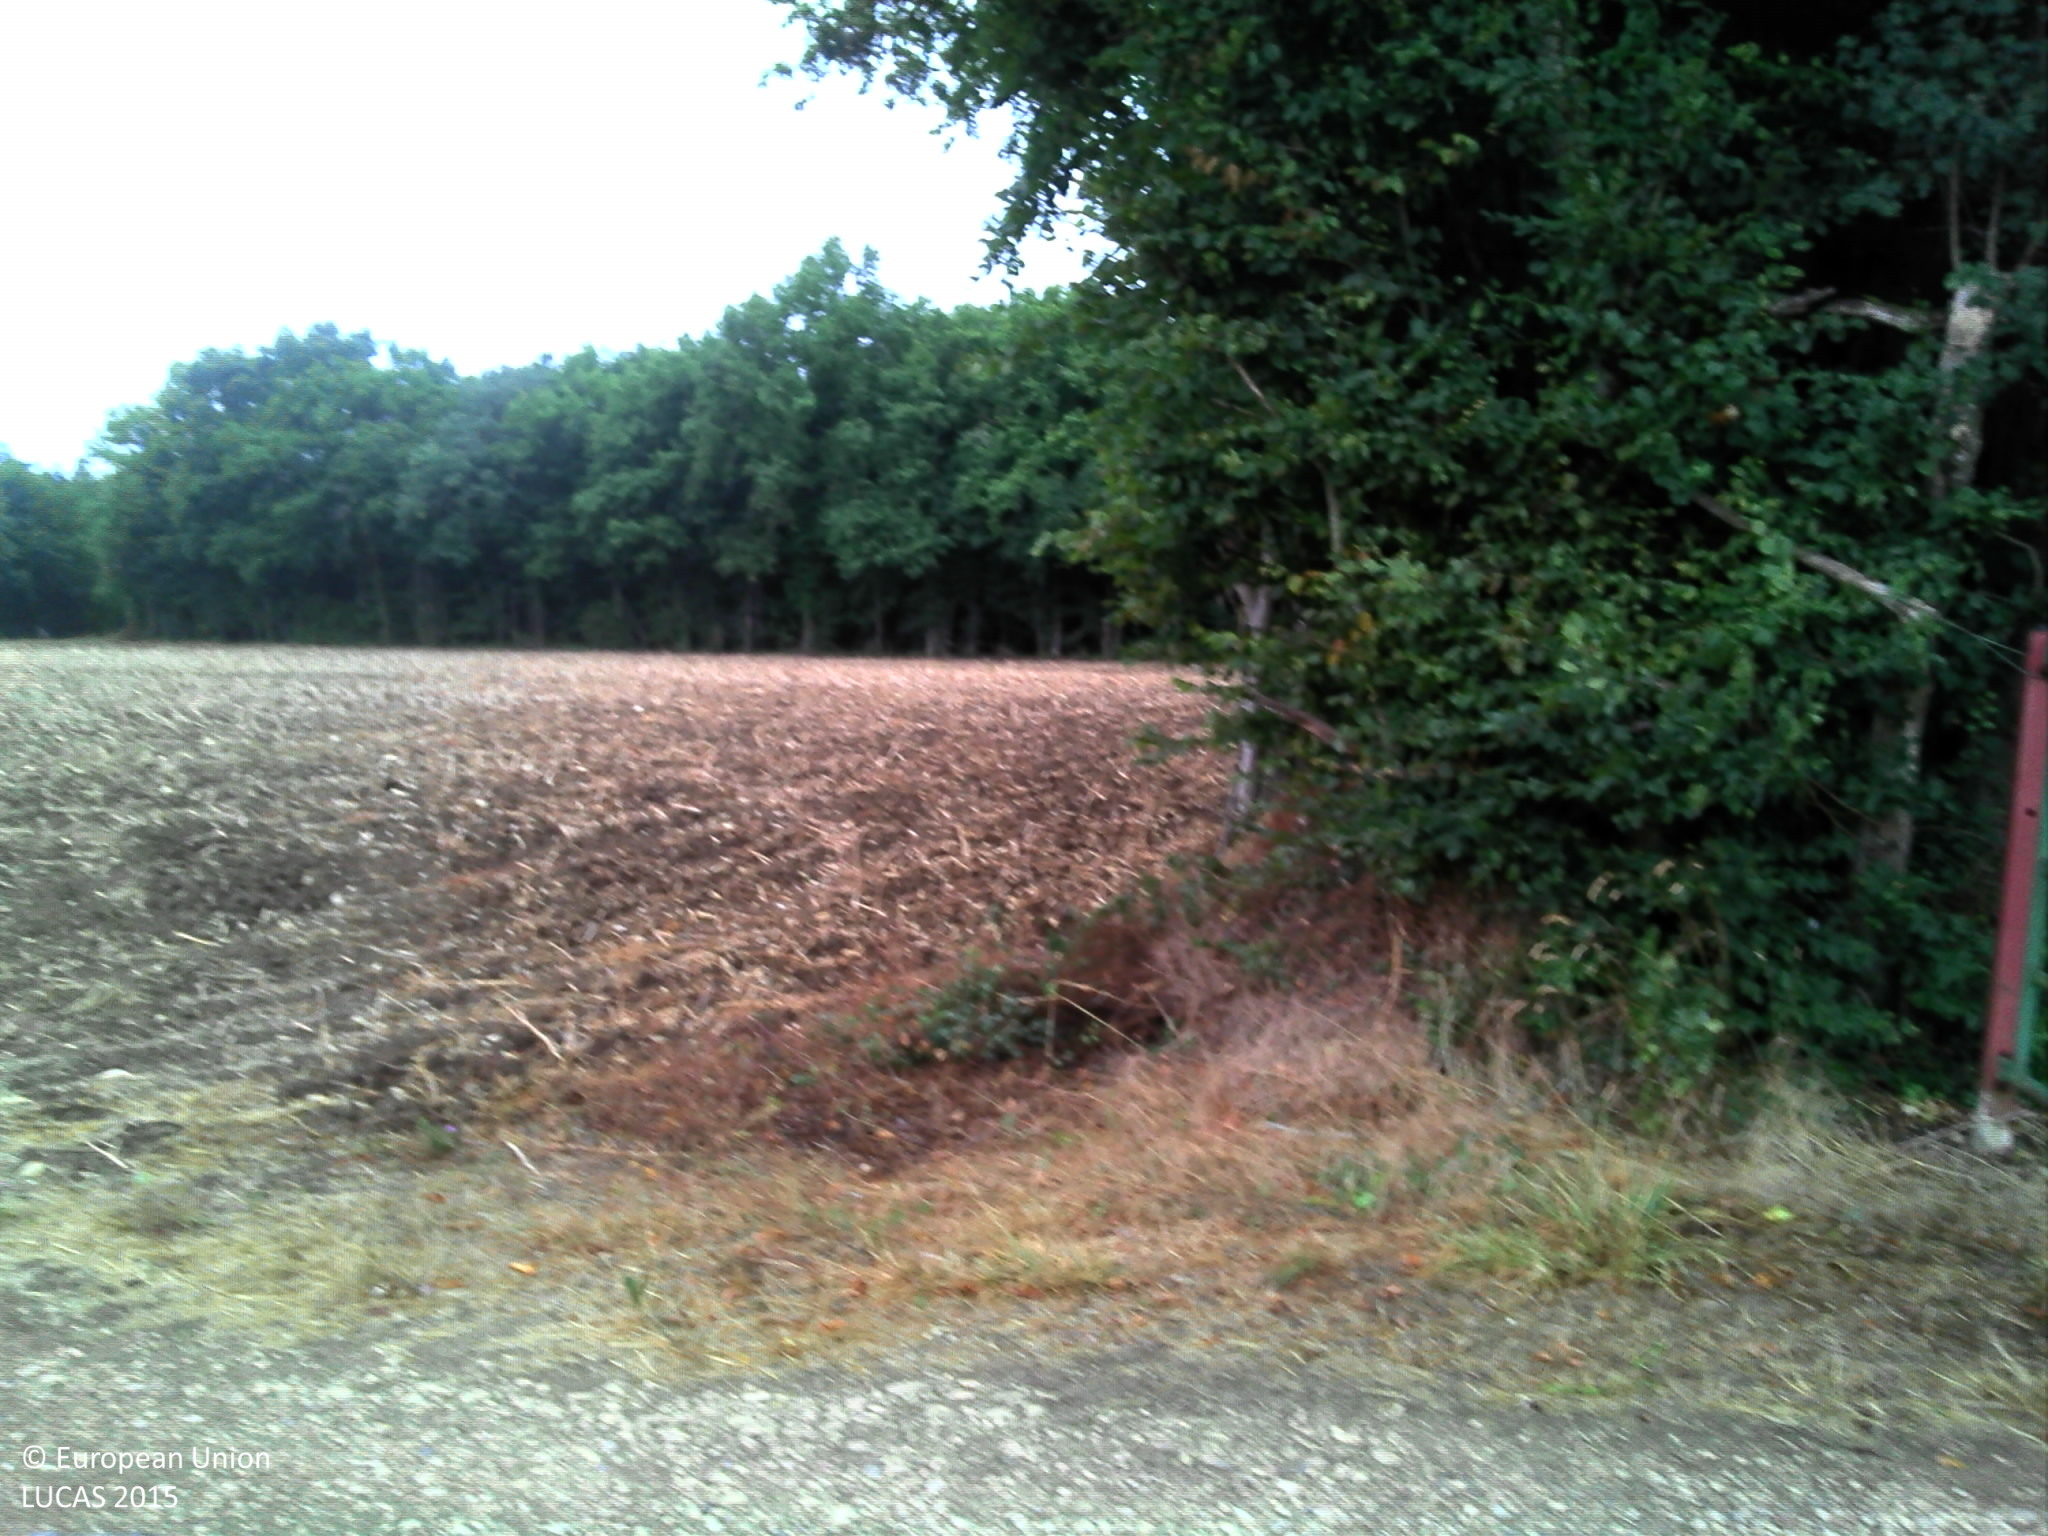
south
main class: Woodland
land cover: Broadleaved woodland
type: mesophytic deciduous forest
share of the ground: > 75 %
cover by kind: broadleaved forest trees 100 %
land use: Forestry
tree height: > 5 m
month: July
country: FR
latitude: 46.8573
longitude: 2.1354
